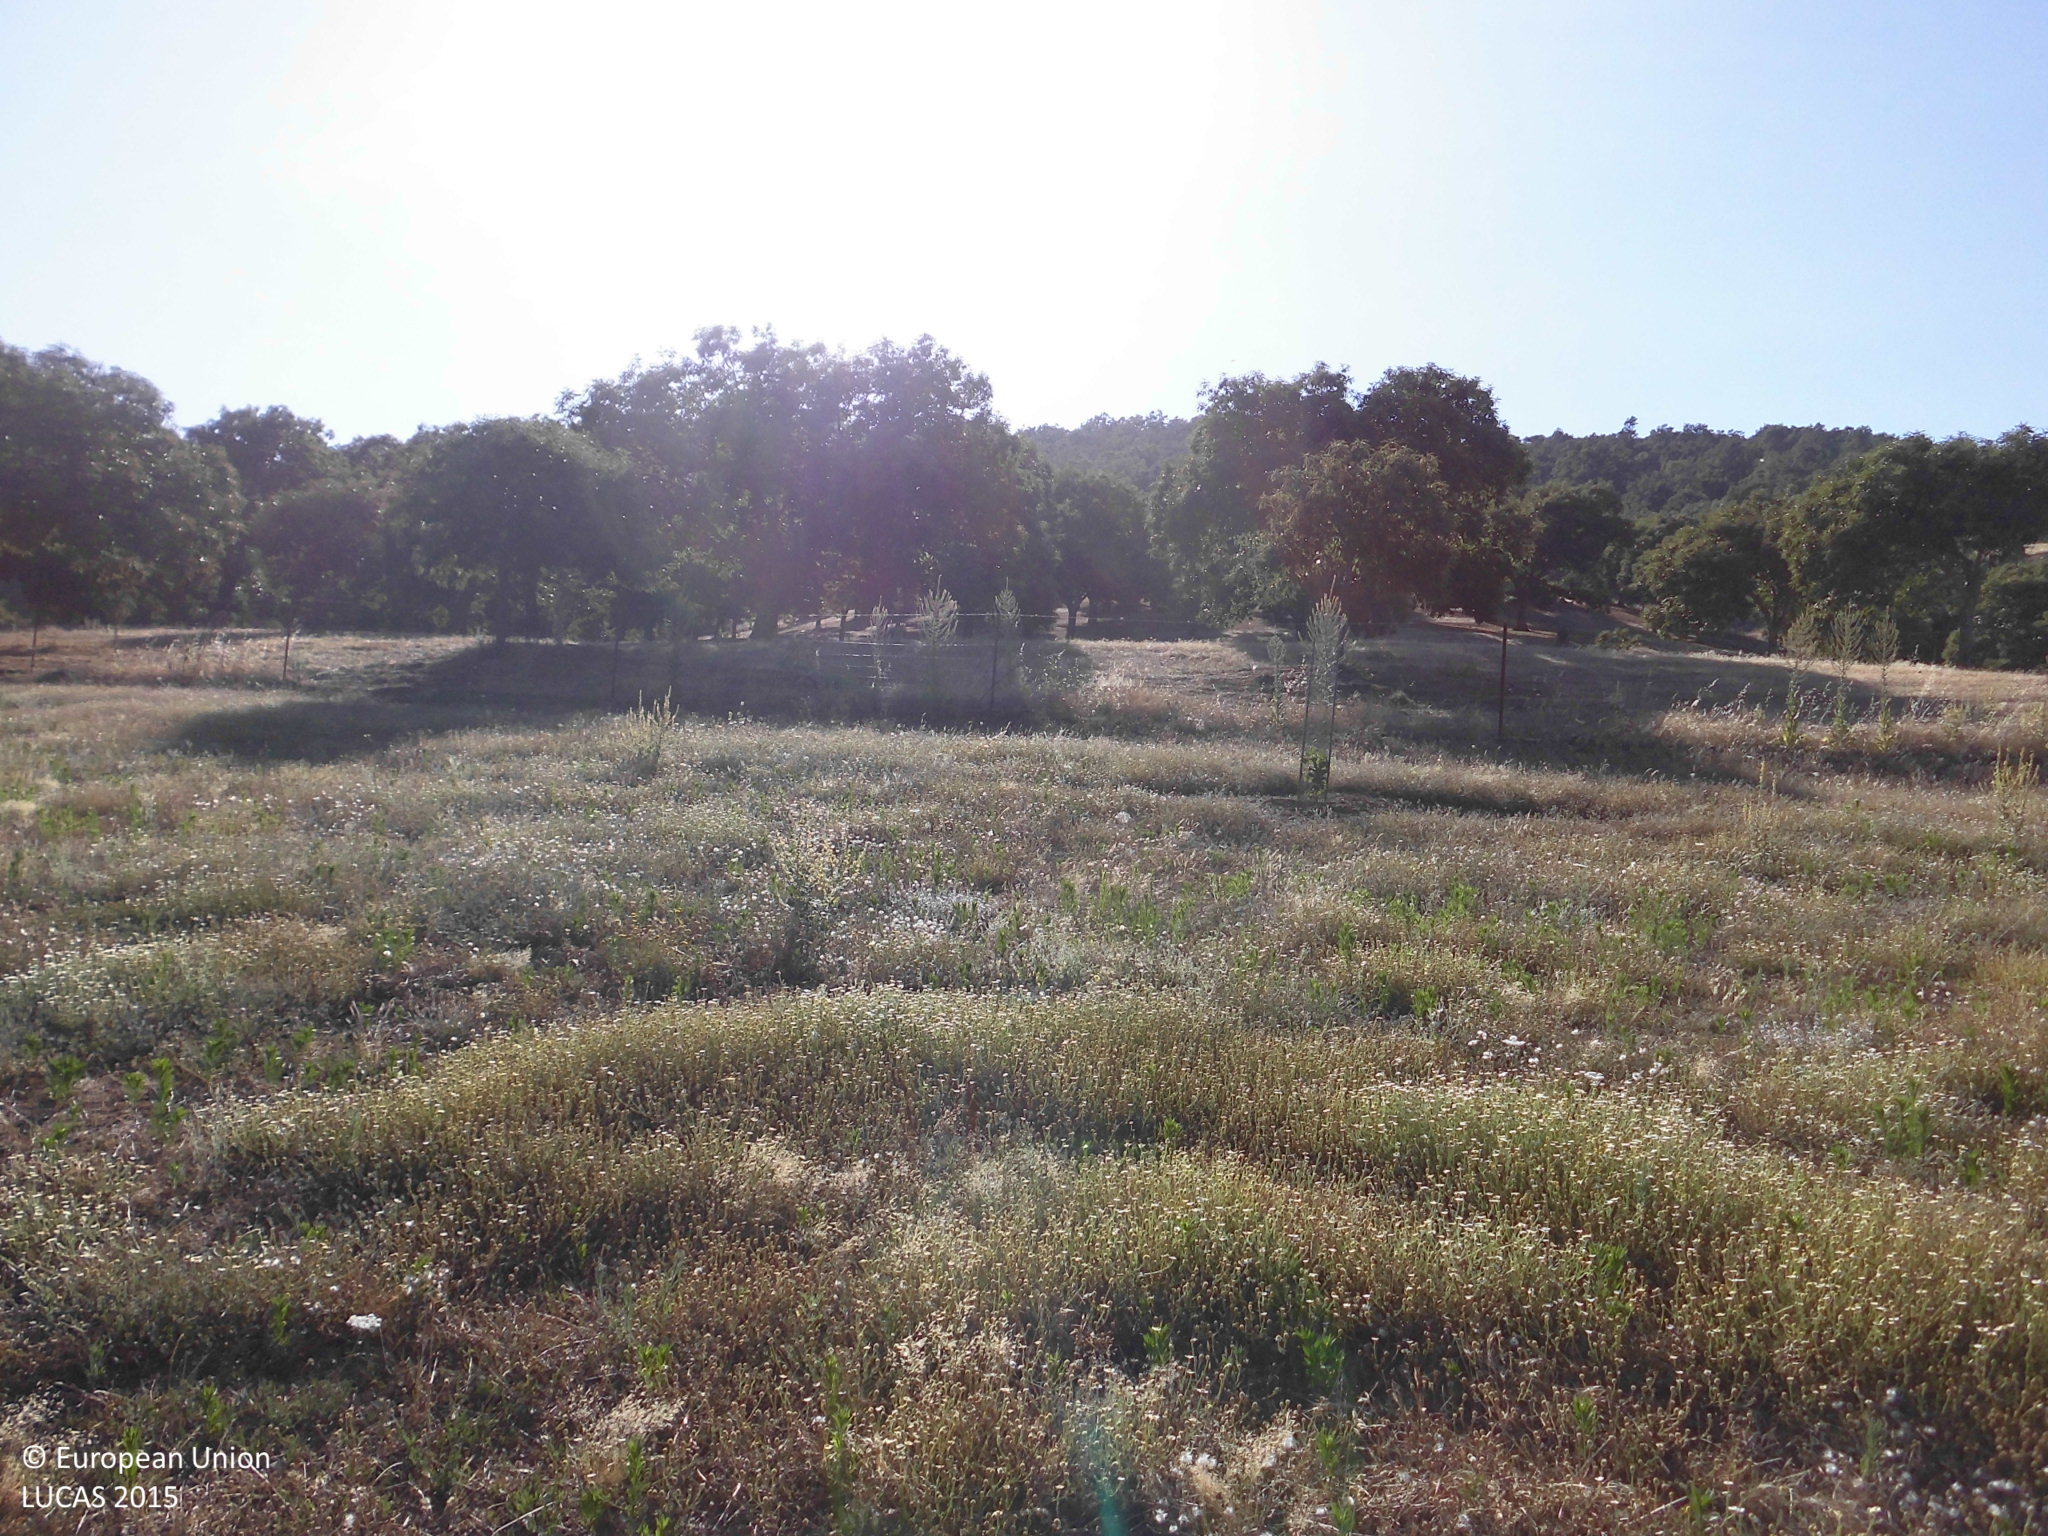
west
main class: Cropland
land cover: Nuts trees
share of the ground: < 10 %
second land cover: Grassland without tree/shrub cover
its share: > 75 %
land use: Agriculture (excluding fallow land and kitchen gardens)
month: July
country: ES
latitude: 39.4044
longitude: -5.5548
